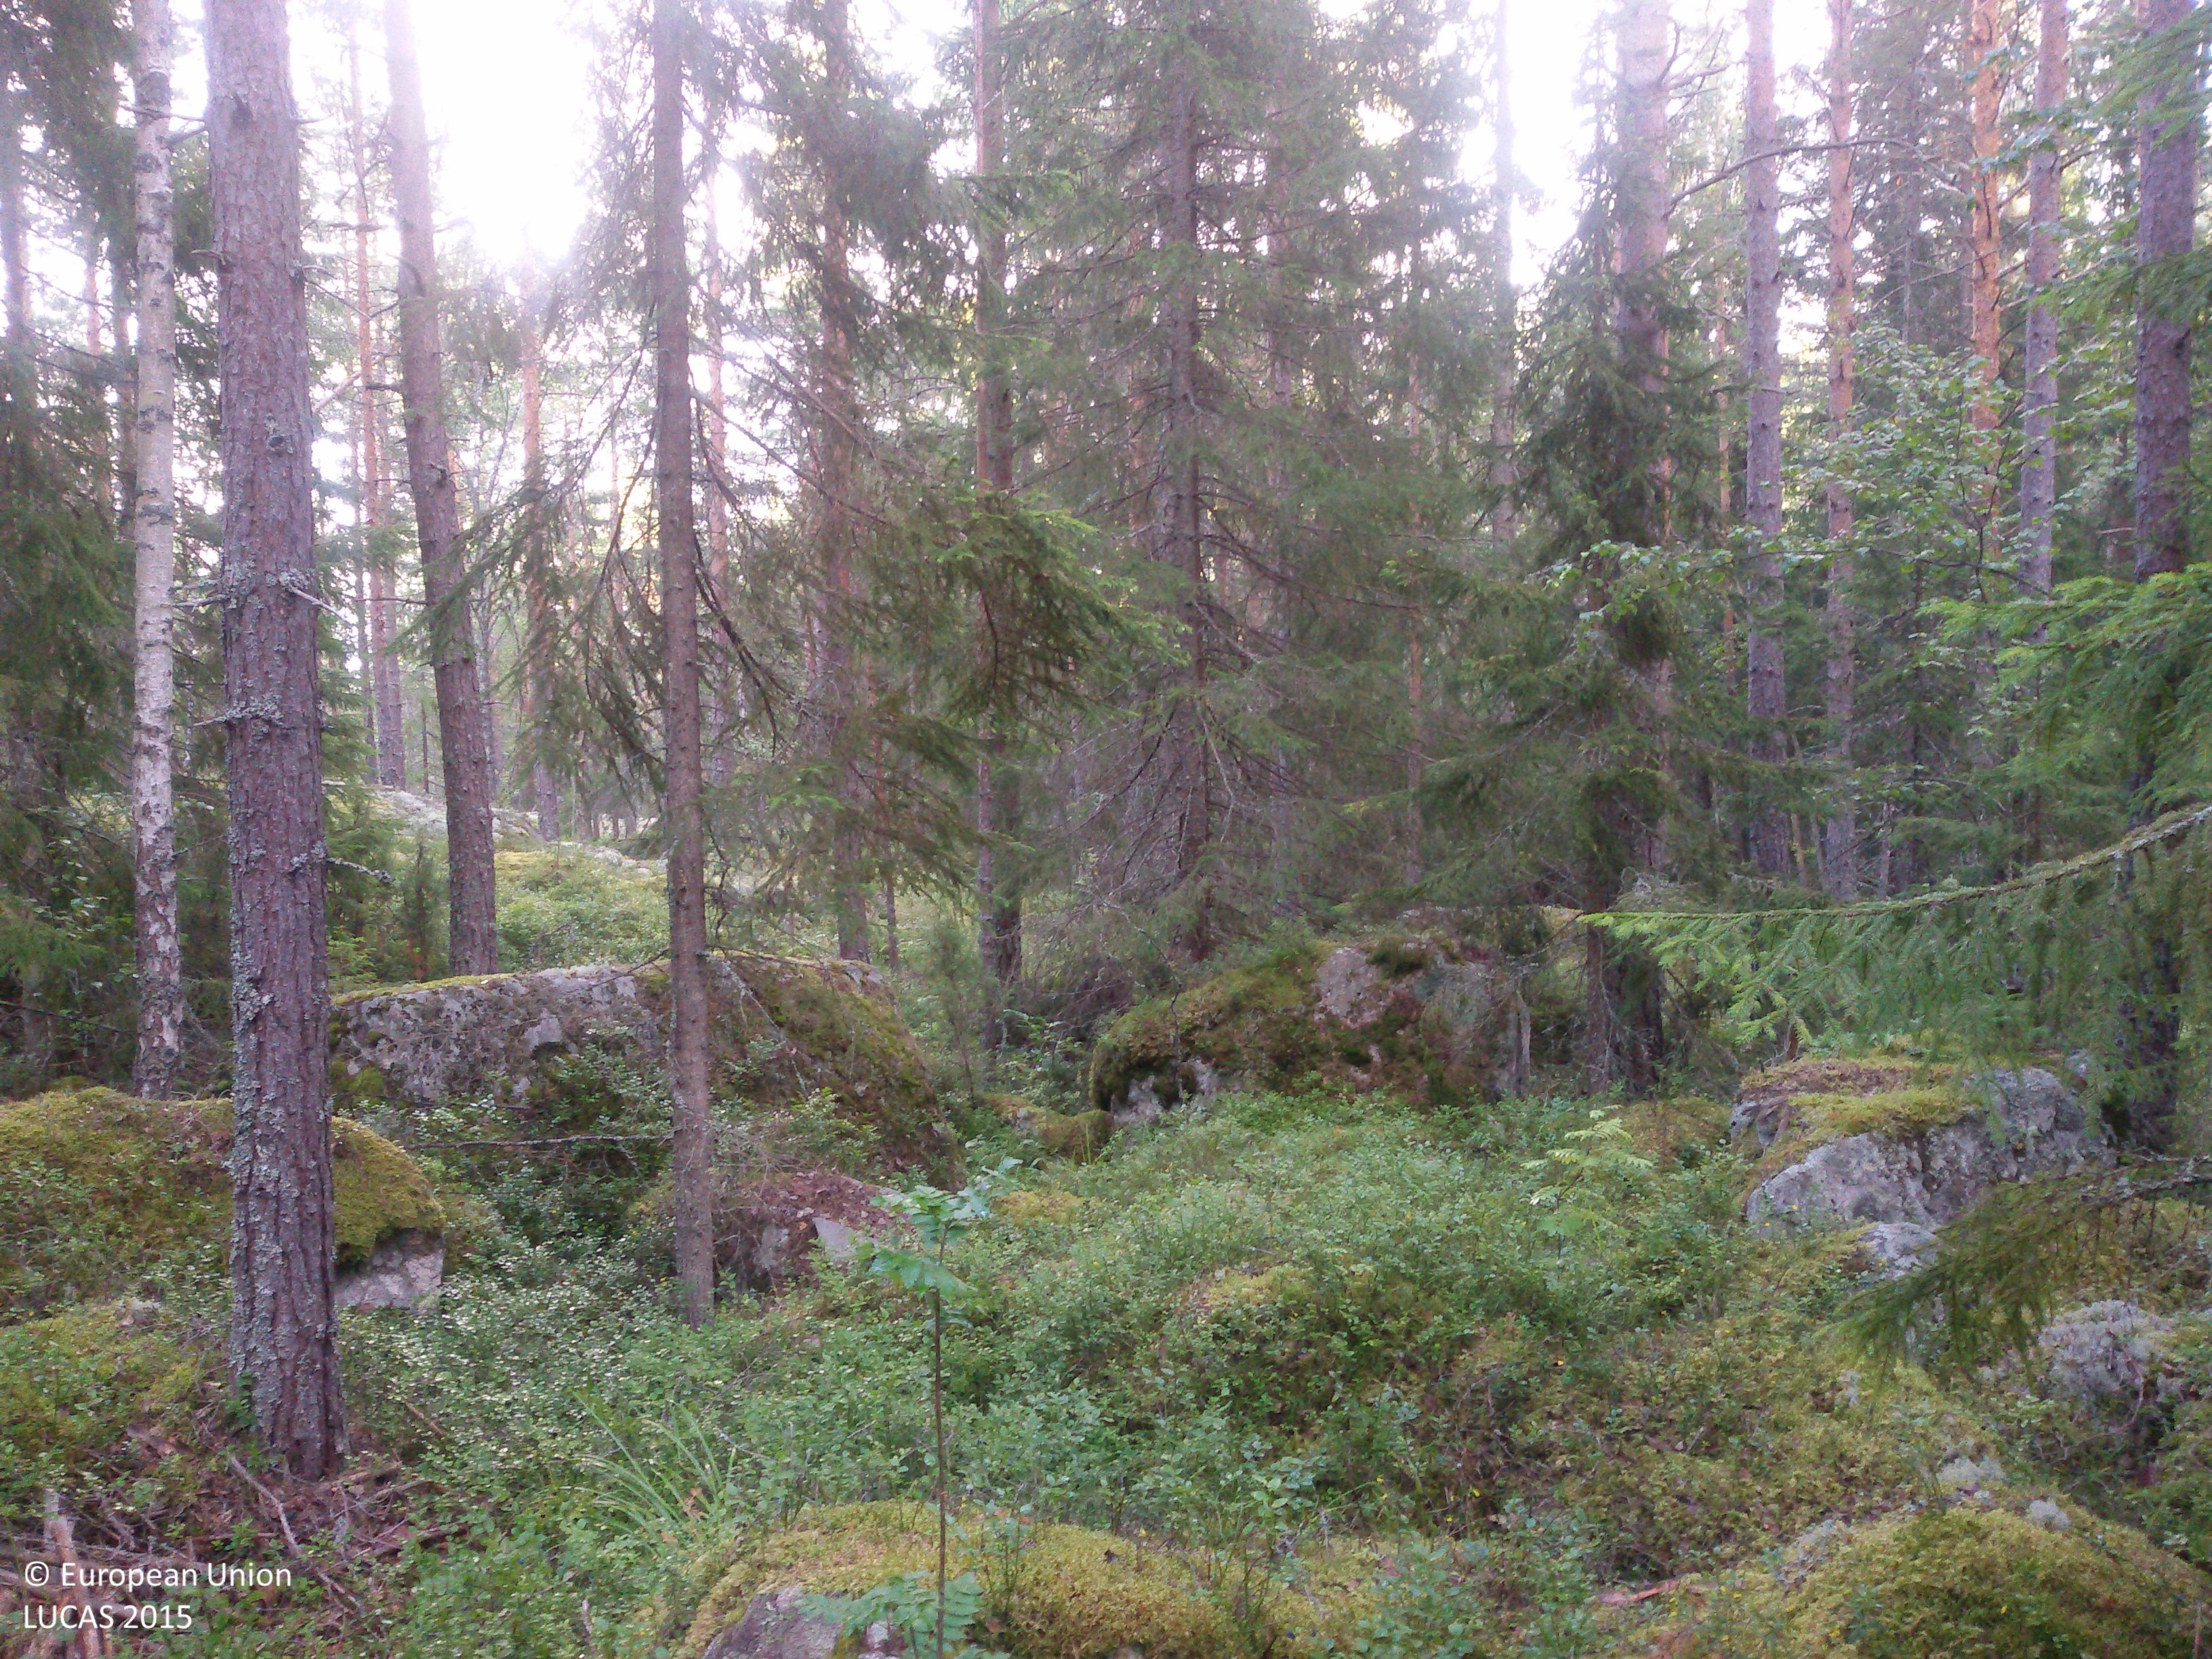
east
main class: Woodland
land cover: Pine dominated coniferous woodland
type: boreal forest
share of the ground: > 75 %
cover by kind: coniferous forest trees 80 %, shrubs 10 %, lichens and mosses 10 %
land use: Forestry
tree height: > 5 m
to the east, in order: Pine dominated coniferous woodland
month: August
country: SE
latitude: 60.5403
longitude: 16.4228
